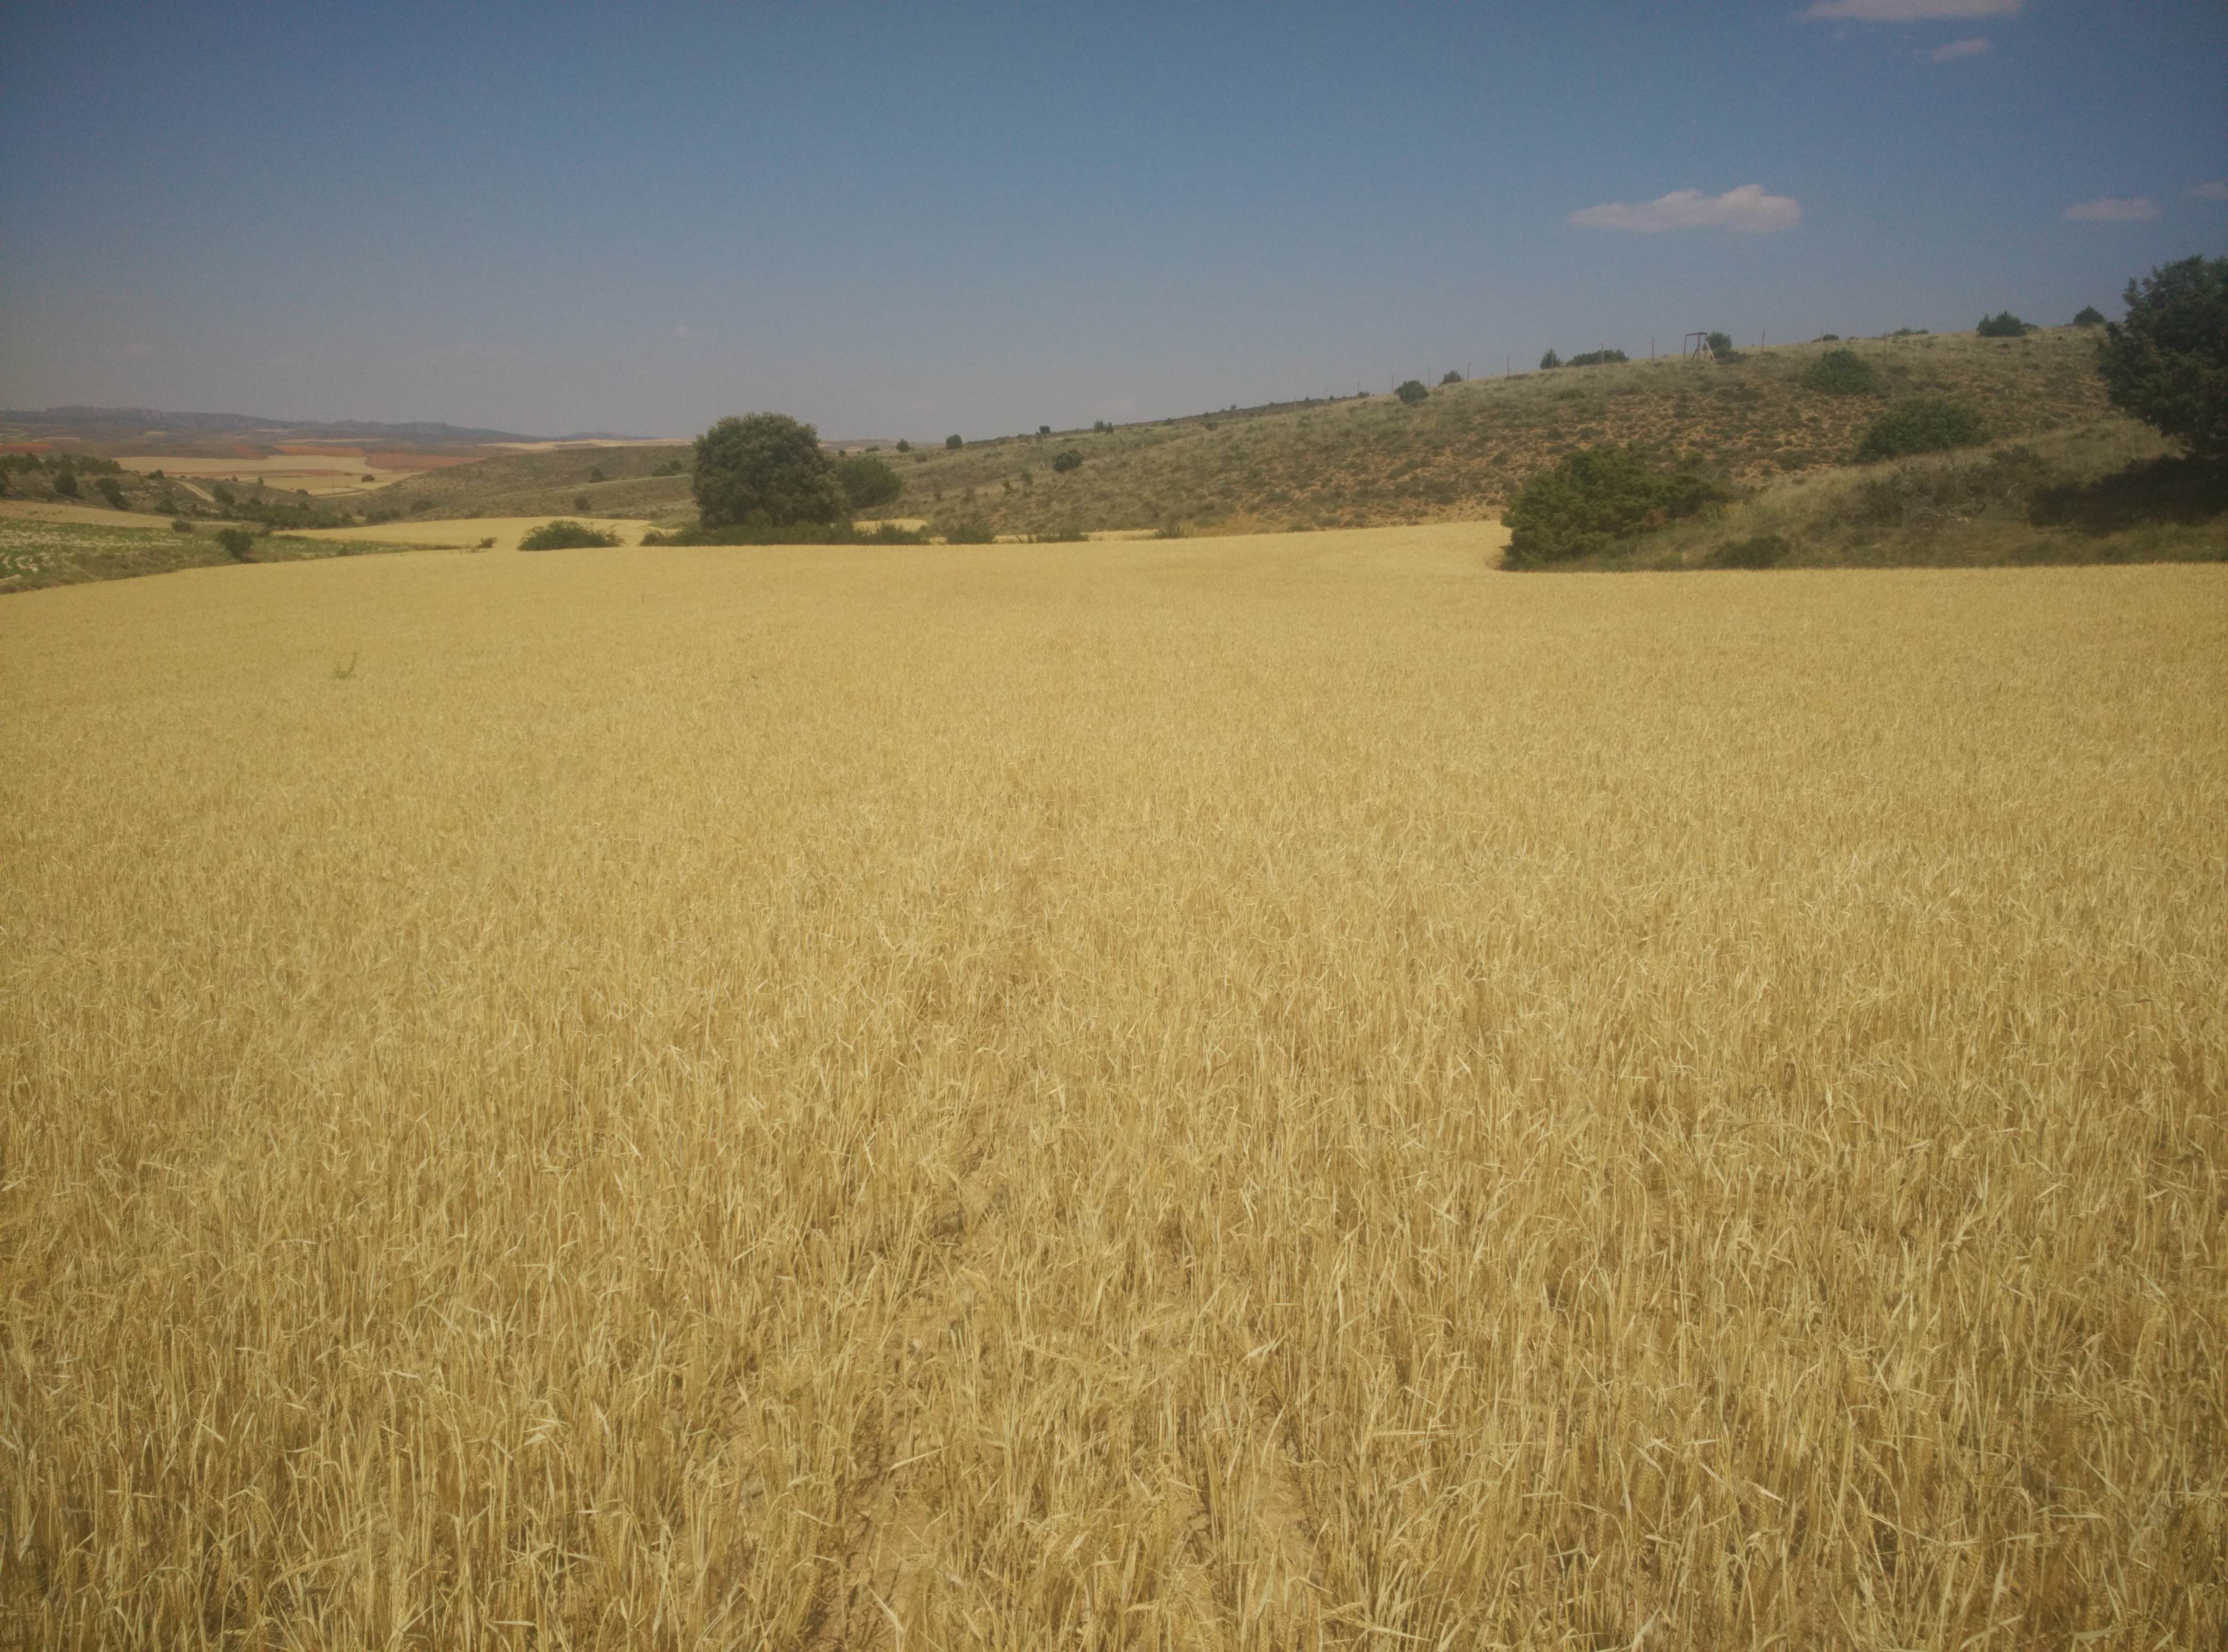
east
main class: Cropland
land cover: Barley
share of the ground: > 75 %
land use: Agriculture (excluding fallow land and kitchen gardens)
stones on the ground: 25 - 50 %
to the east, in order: Barley; Shrubland without tree cover
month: June
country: ES
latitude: 40.7541
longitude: -1.8298
